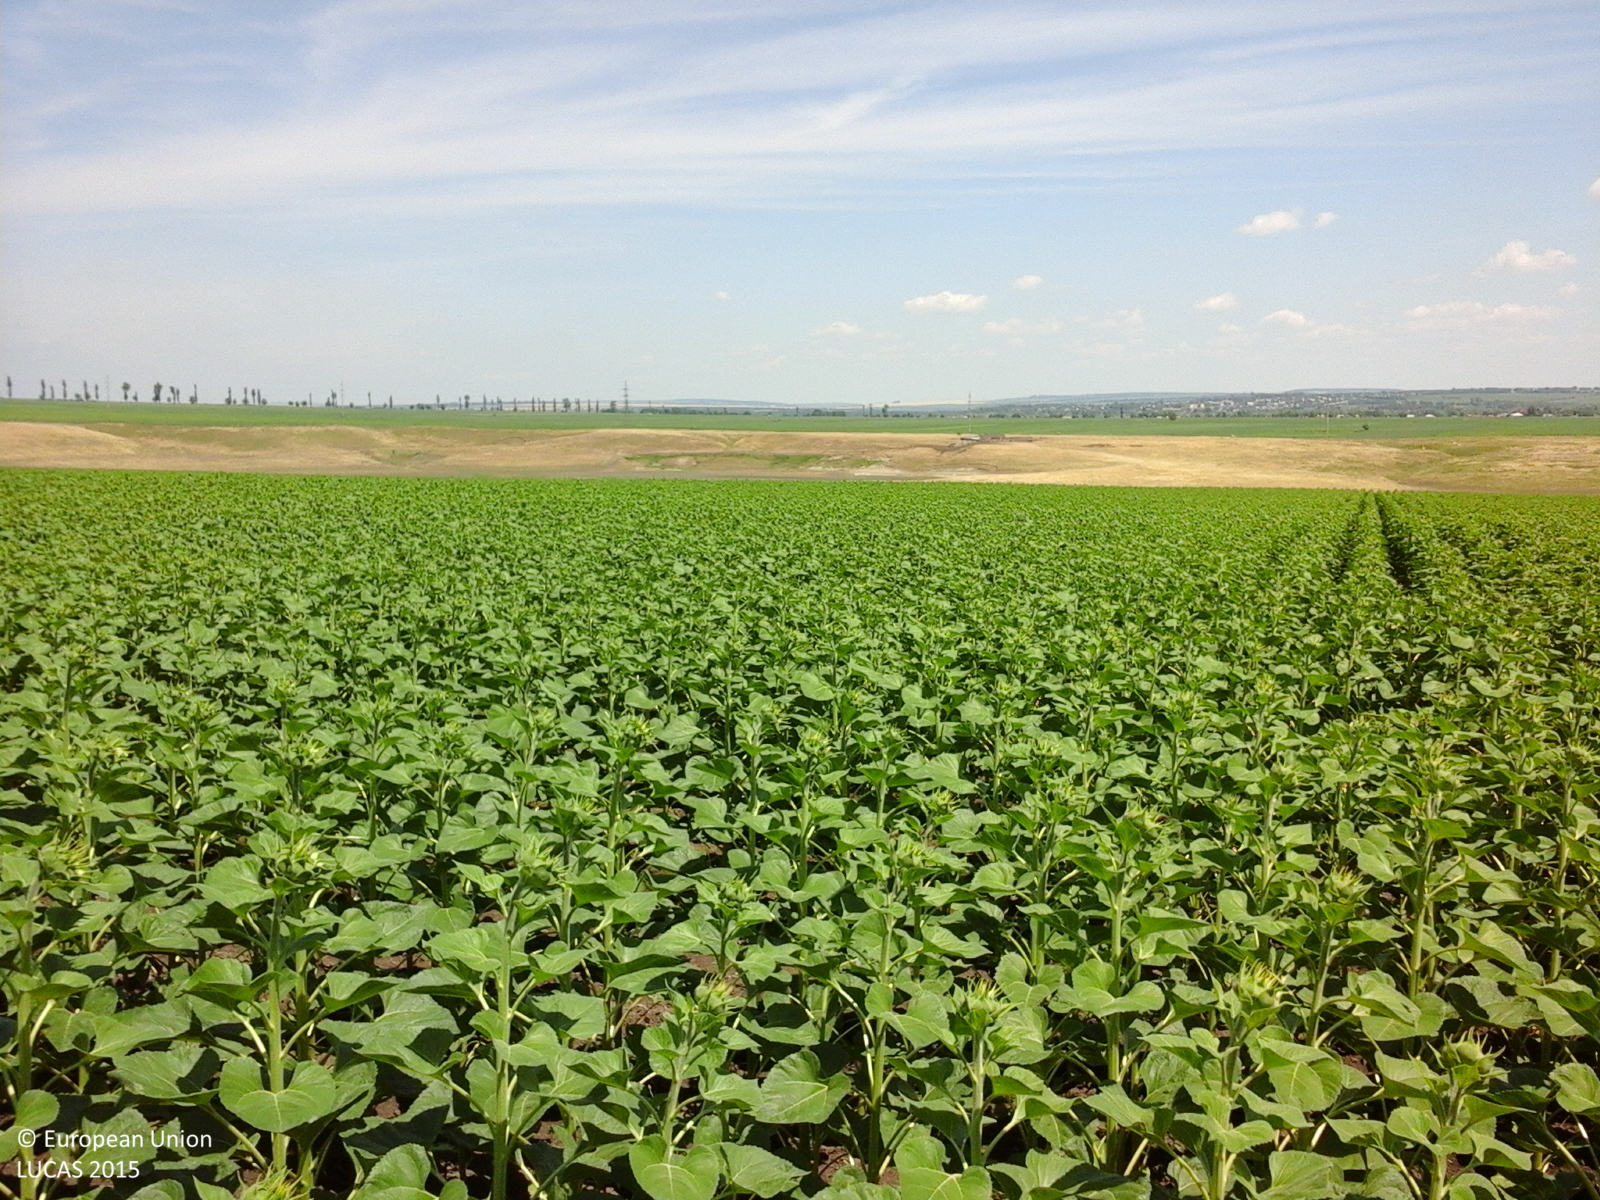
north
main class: Cropland
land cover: Sunflower
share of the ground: > 75 %
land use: Agriculture (excluding fallow land and kitchen gardens)
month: June
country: RO
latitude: 47.9761
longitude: 27.1096
